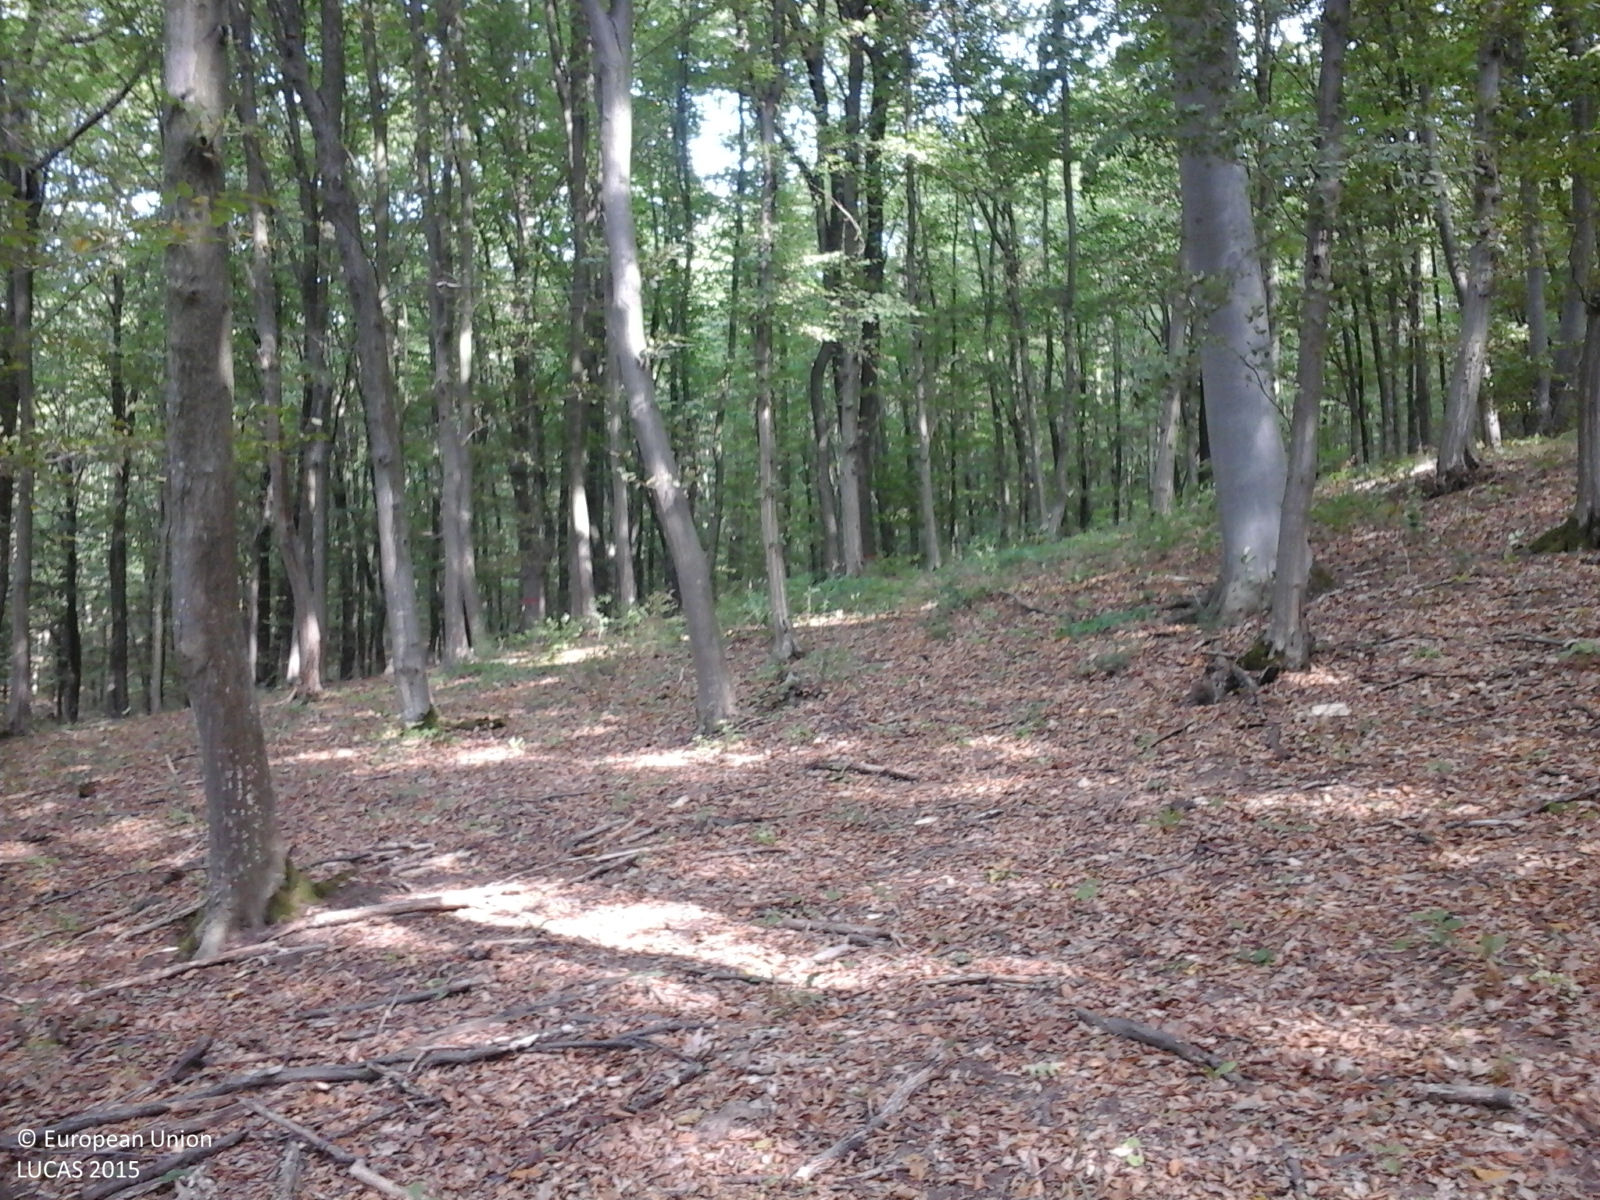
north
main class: Woodland
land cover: Broadleaved woodland
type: acidophilous oak and oak-birch forest
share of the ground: > 75 %
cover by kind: broadleaved forest trees 100 %
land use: Forestry
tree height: > 5 m
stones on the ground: < 10 %
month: September
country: RO
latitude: 45.9387
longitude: 22.8353
